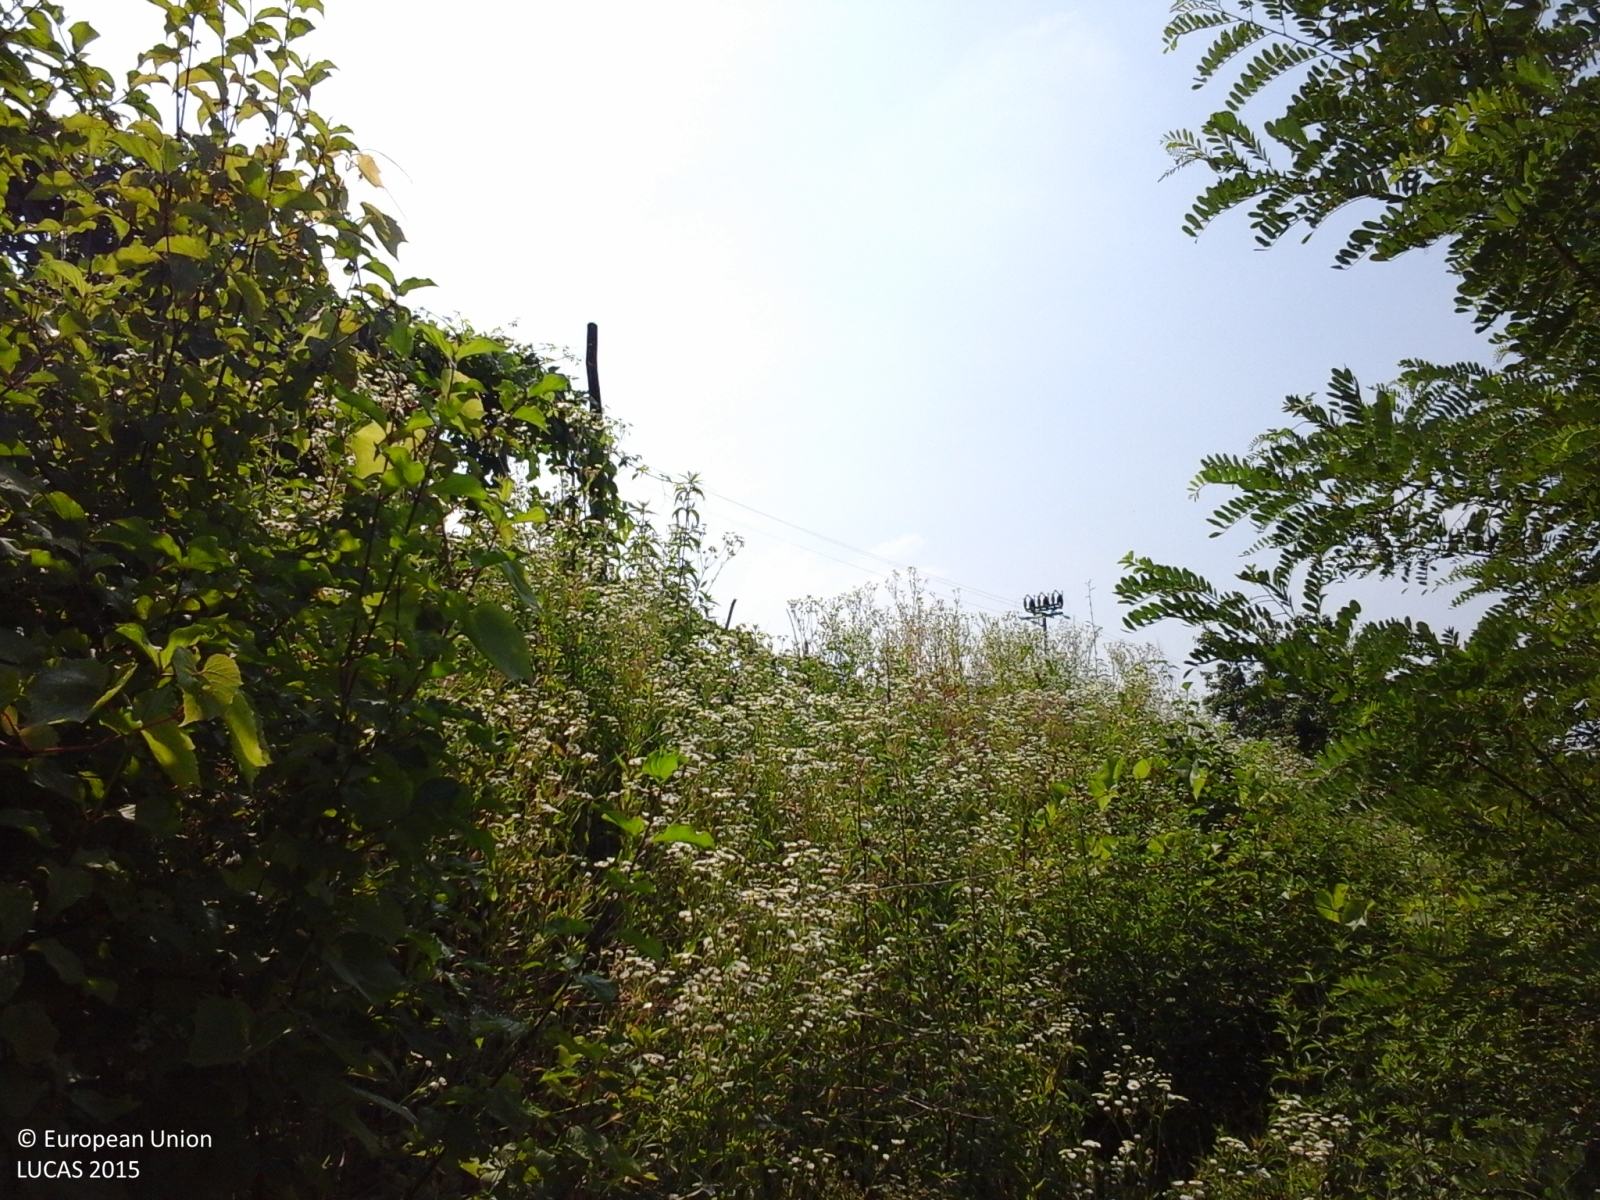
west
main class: Grassland
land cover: Grassland with sparse tree/shrub cover
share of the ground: > 75 %
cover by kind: herbaceous plants 90 %, broadleaved forest trees 5 %, shrubs 5 %
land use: Abandoned areas
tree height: > 5 m
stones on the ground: < 10 %
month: June
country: IT
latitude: 44.6671
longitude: 8.7036
